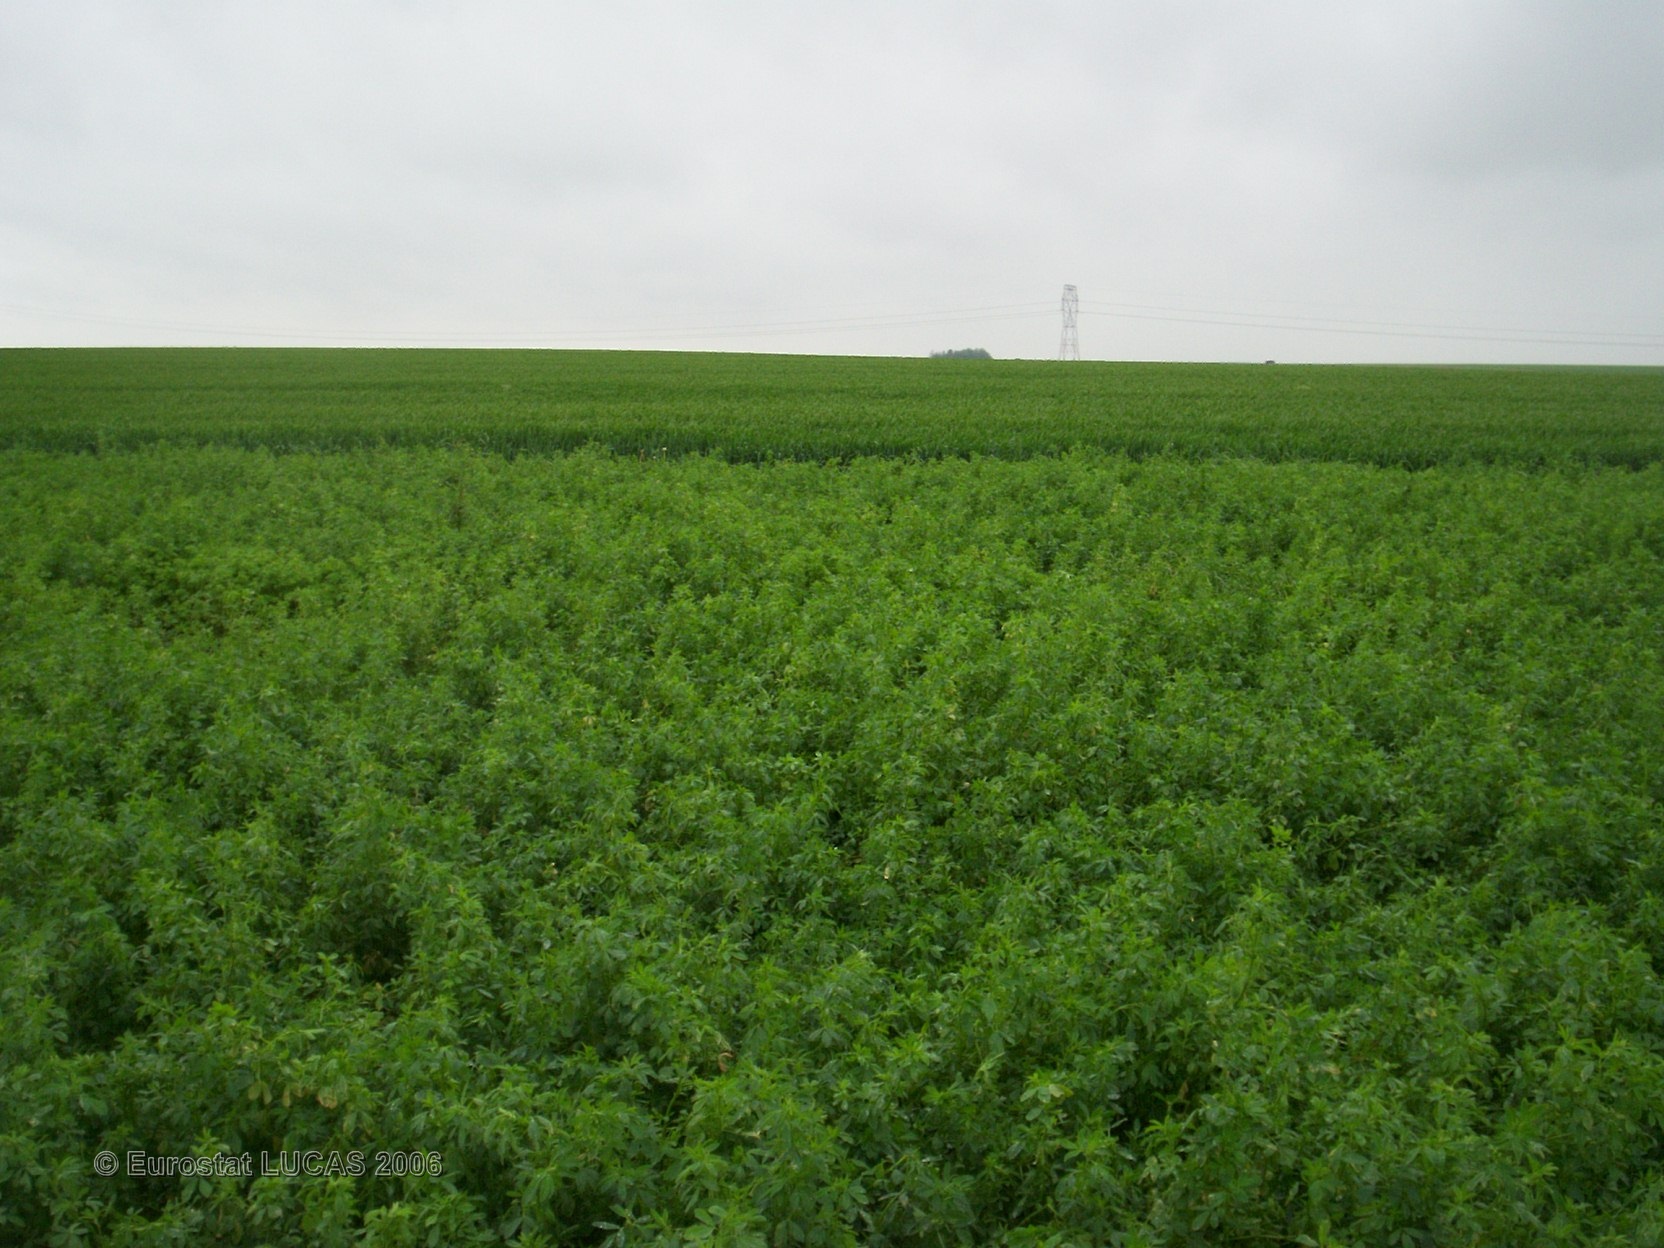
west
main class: Cropland
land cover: Lucerne
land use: Agriculture (excluding fallow land and kitchen gardens)
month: May
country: FR
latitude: 49.3805
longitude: 4.4175
